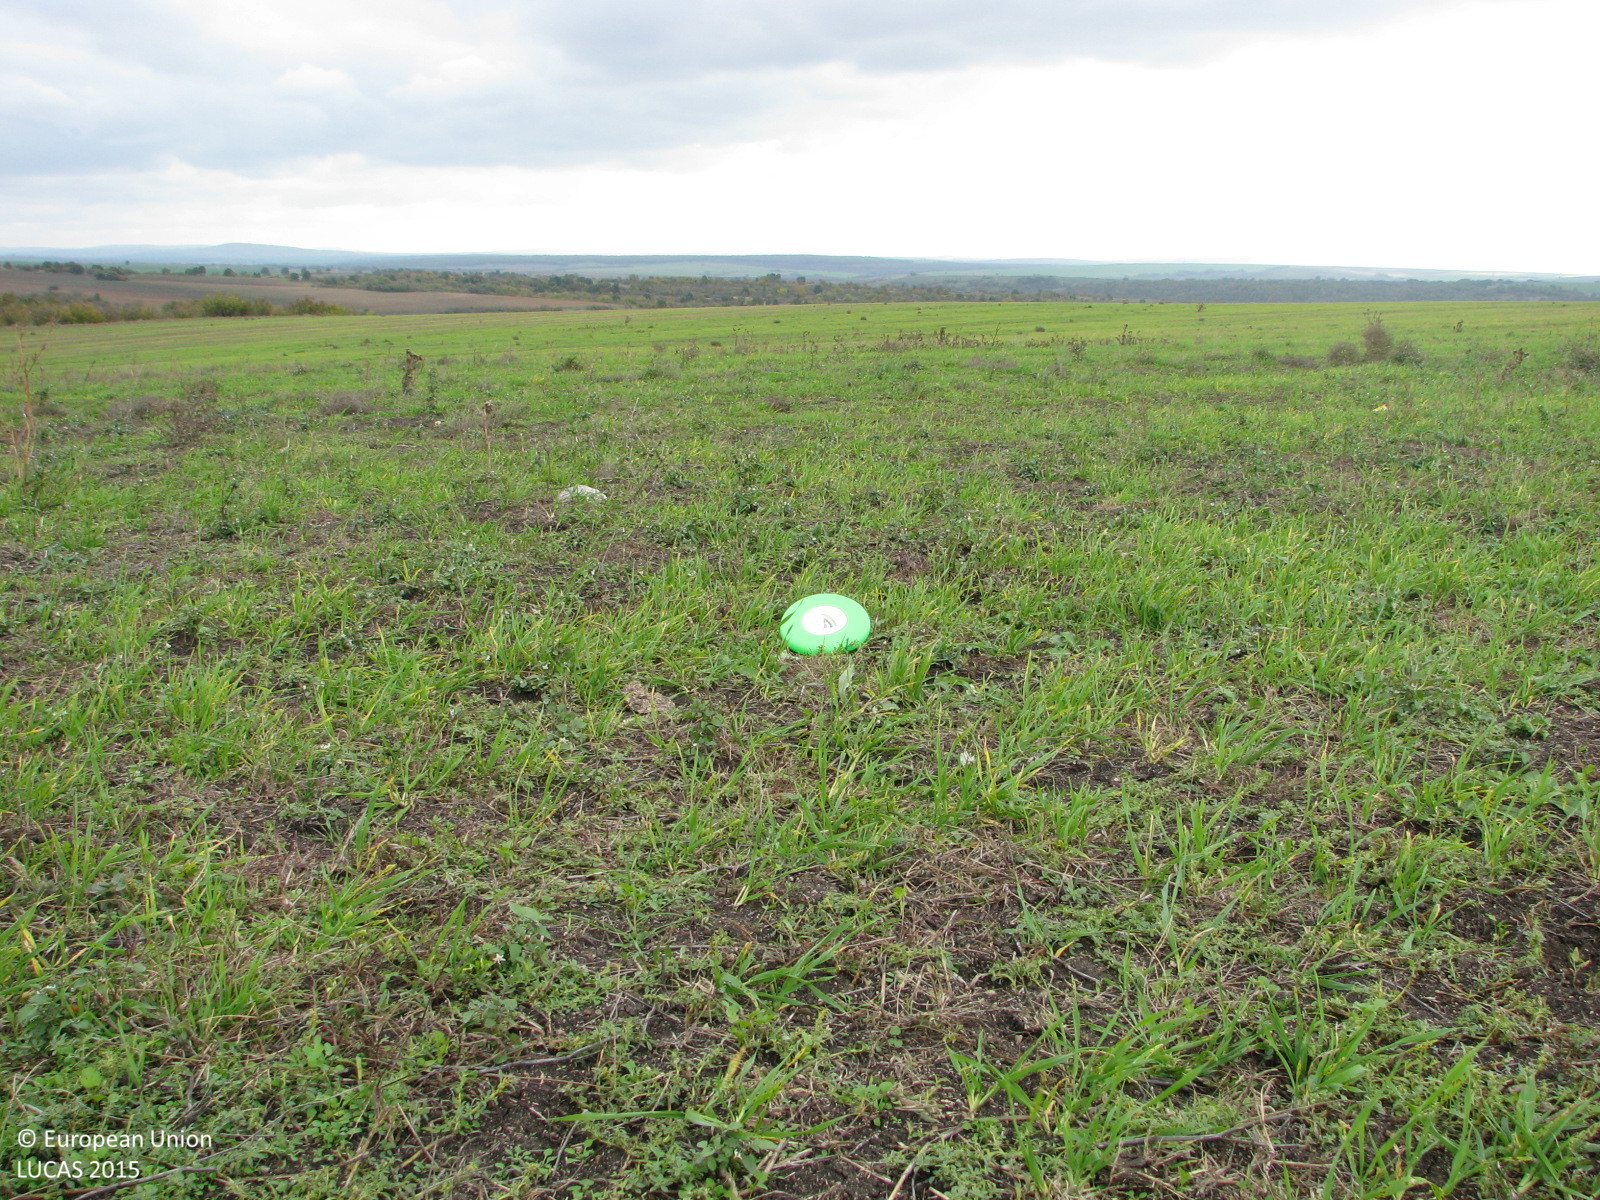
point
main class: Grassland
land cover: Spontaneously vegetated surfaces
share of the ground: > 75 %
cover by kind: herbaceous plants 80 %, unconsolidated bare surface 20 %
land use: Agriculture (excluding fallow land and kitchen gardens)
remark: Harvested field
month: October
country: BG
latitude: 42.2224
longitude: 26.7530
